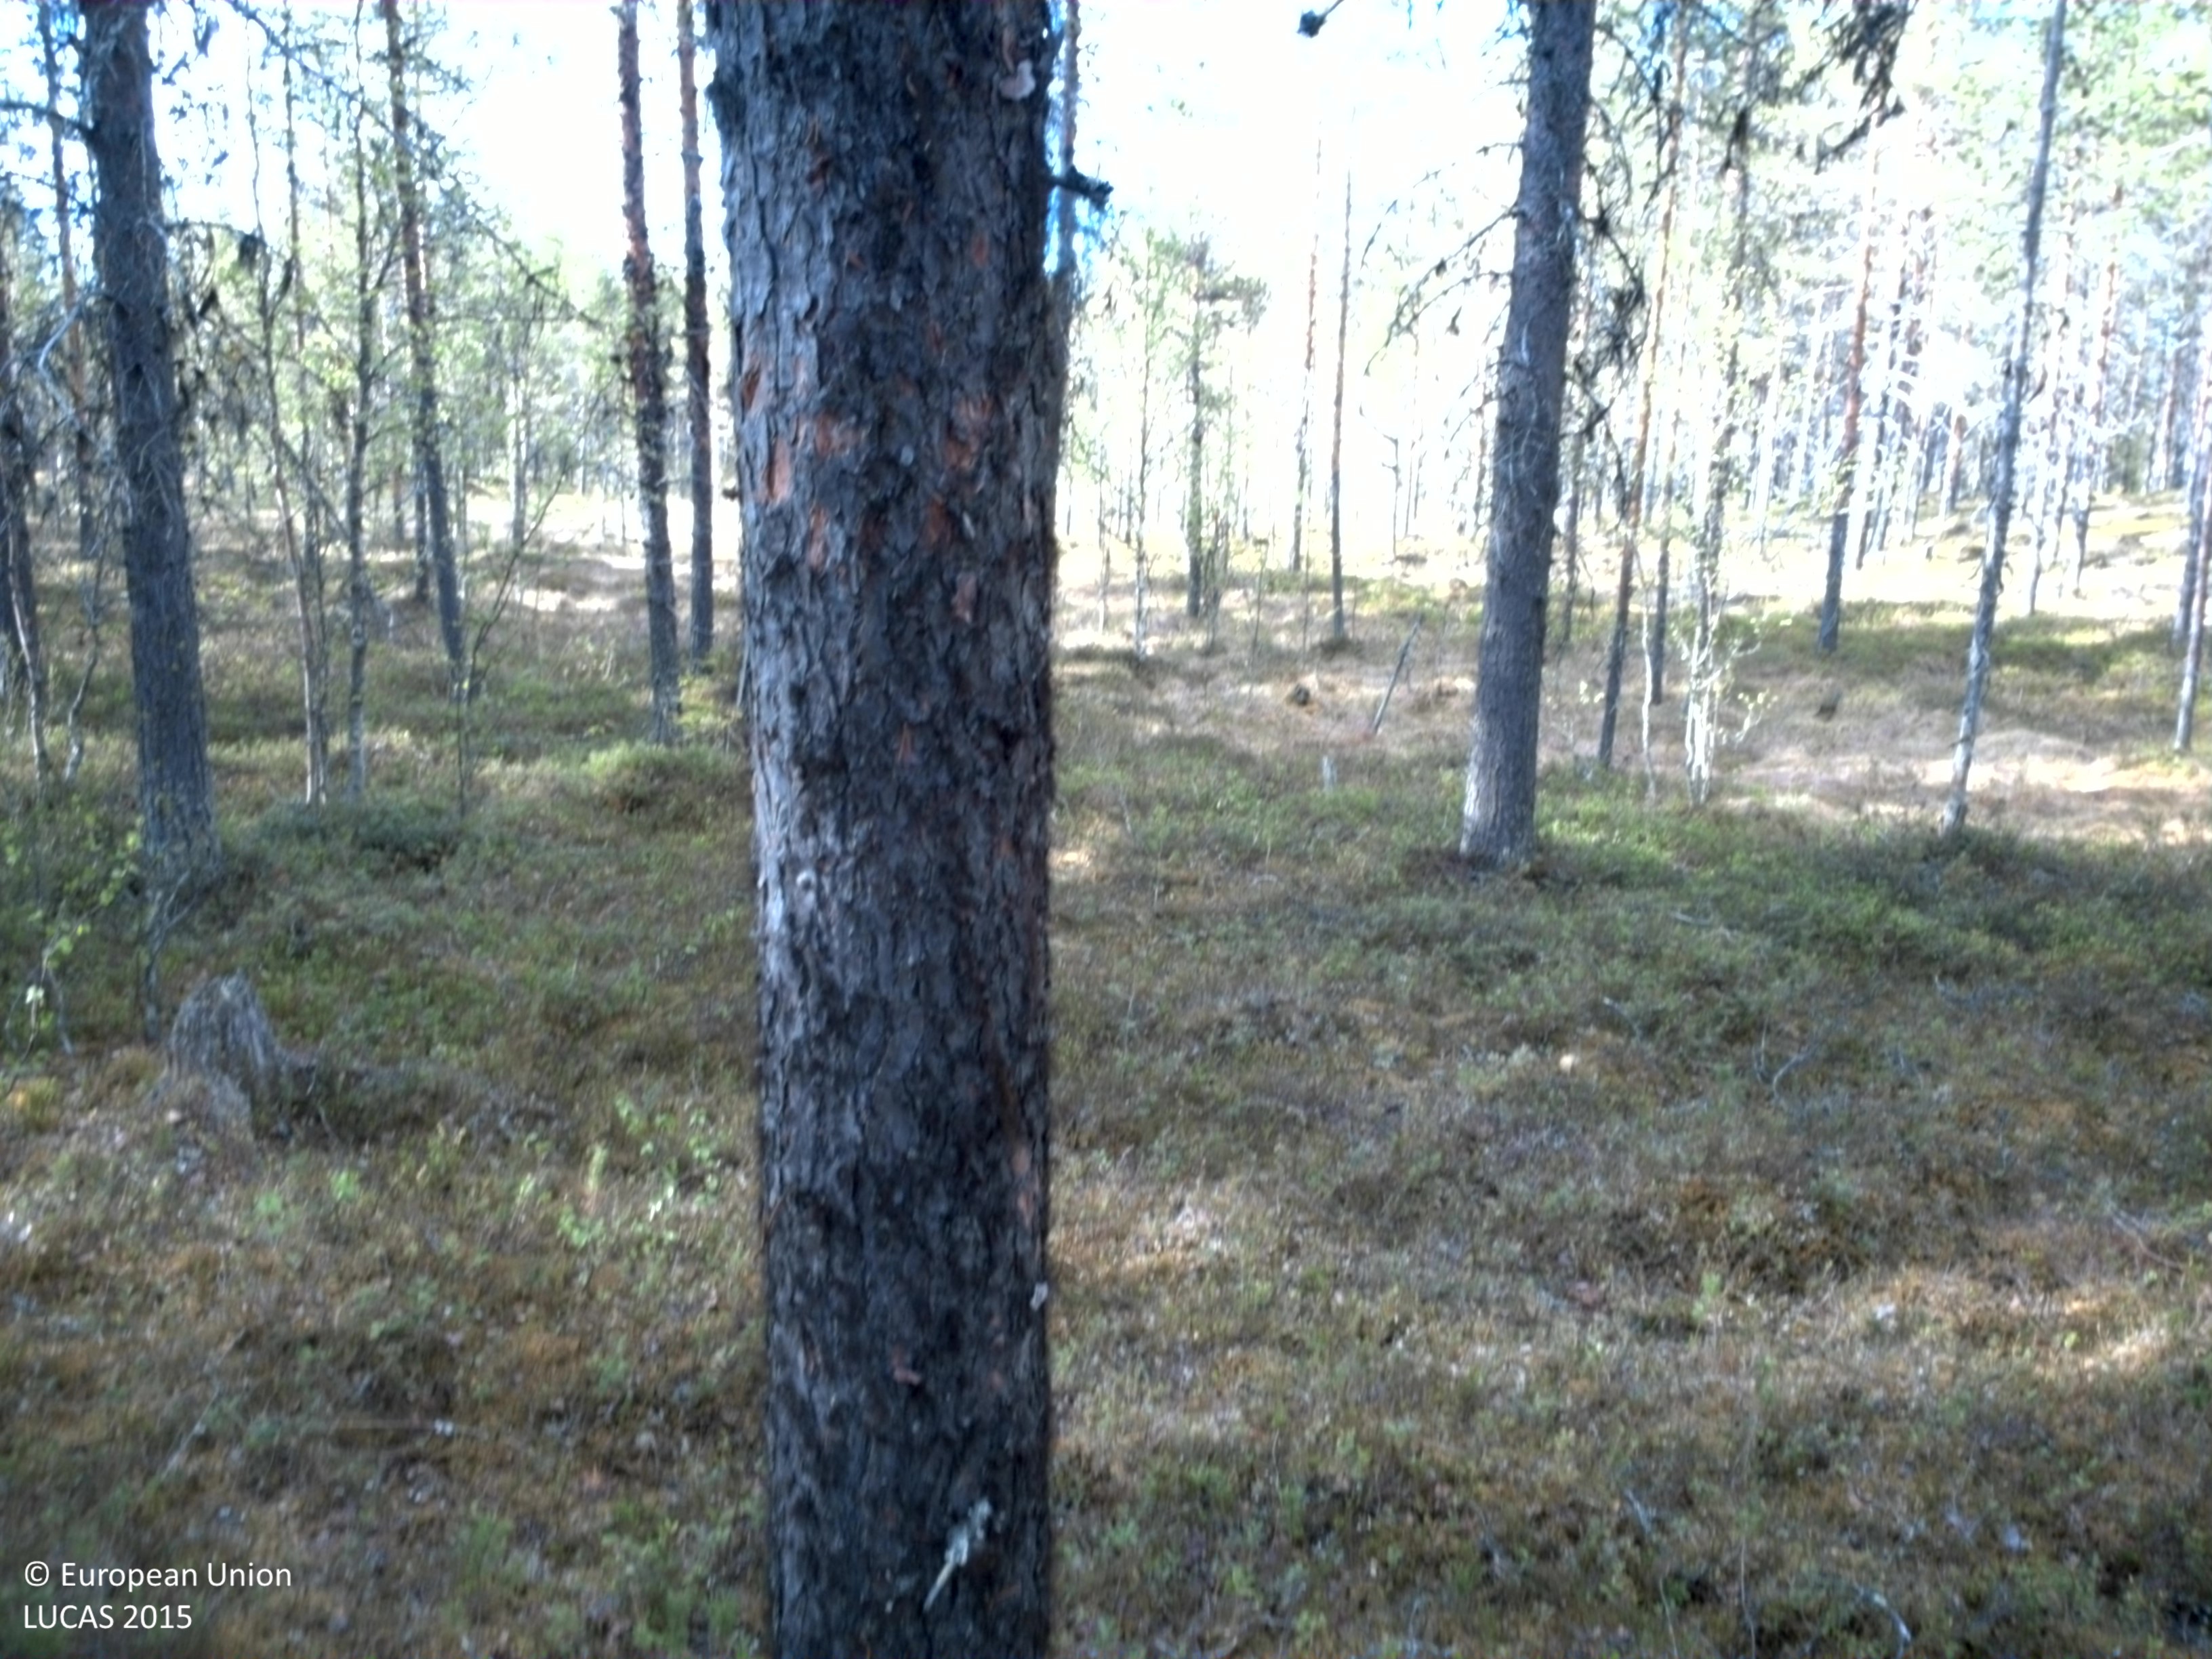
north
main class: Woodland
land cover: Pine dominated coniferous woodland
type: boreal forest
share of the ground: 25 - 50 %
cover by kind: shrubs 55 %, coniferous forest trees 40 %, broadleaved forest trees 5 %
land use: Forestry
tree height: > 5 m
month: June
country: SE
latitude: 65.8631
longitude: 19.4923
